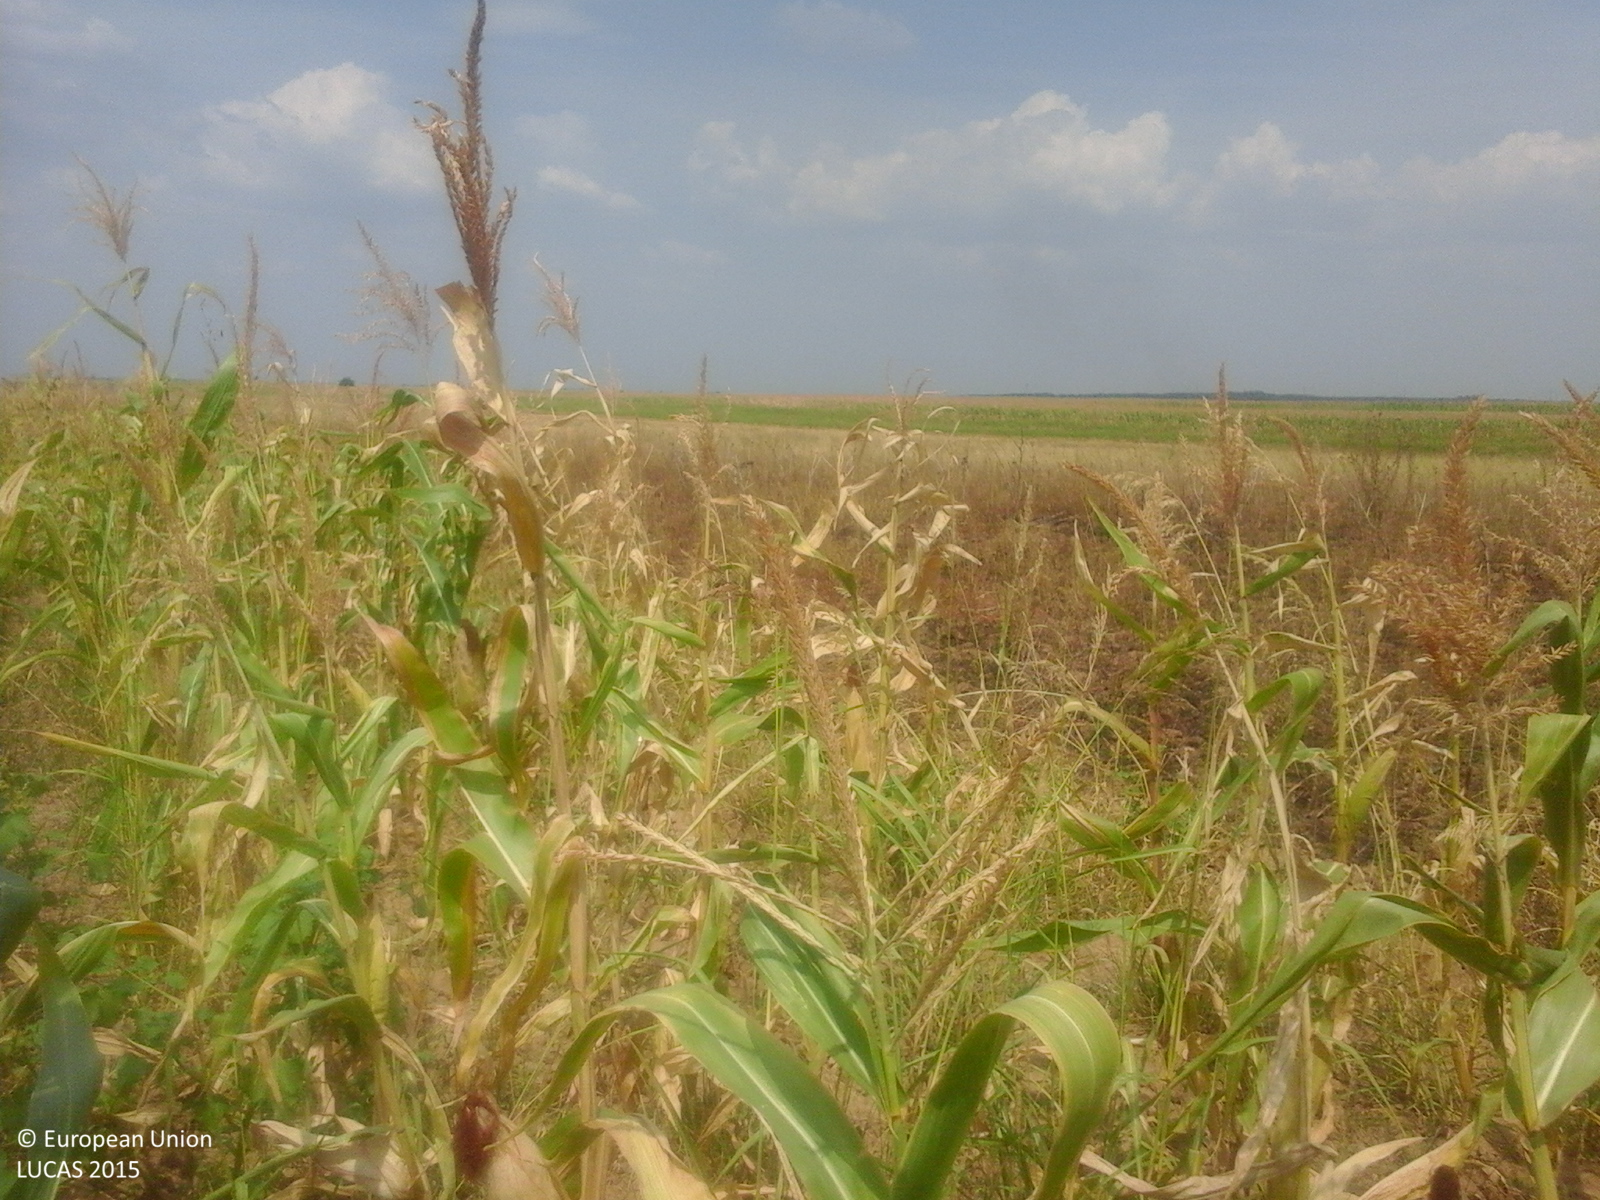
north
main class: Cropland
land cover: Maize
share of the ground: > 75 %
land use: Agriculture (excluding fallow land and kitchen gardens)
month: August
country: RO
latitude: 44.3212
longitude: 22.7929
